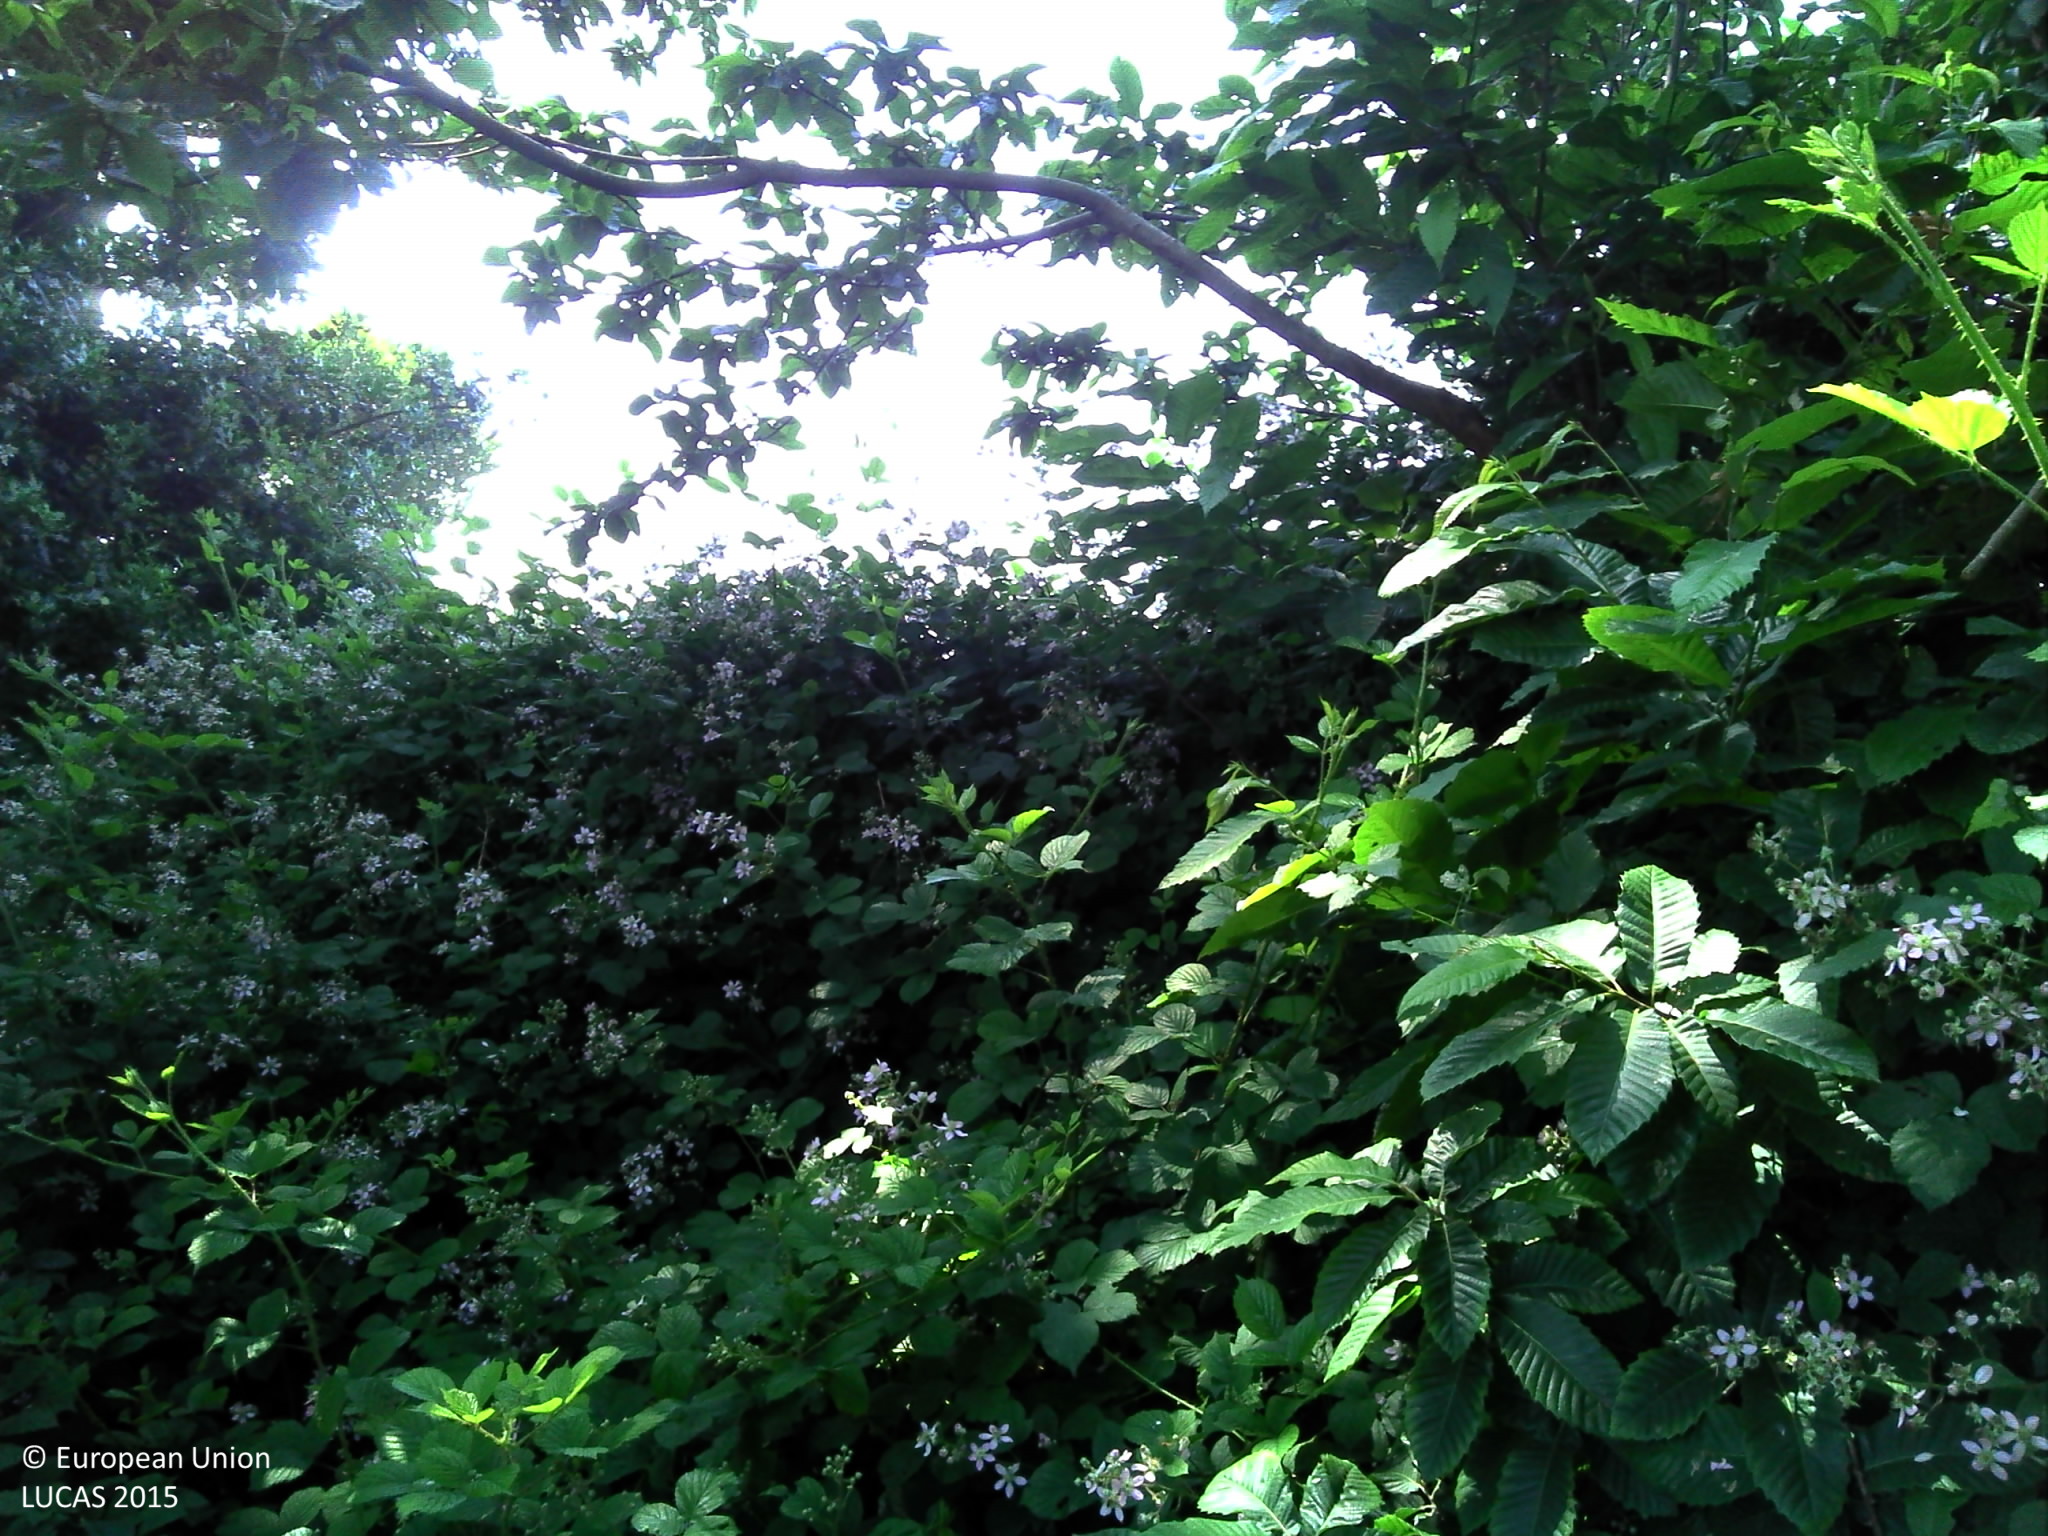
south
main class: Woodland
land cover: Broadleaved woodland
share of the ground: > 75 %
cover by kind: broadleaved forest trees 75 %, herbaceous plants 20 %, unconsolidated bare surface 5 %
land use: Forestry
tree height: > 5 m
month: June
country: FR
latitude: 48.3328
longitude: -1.7998
